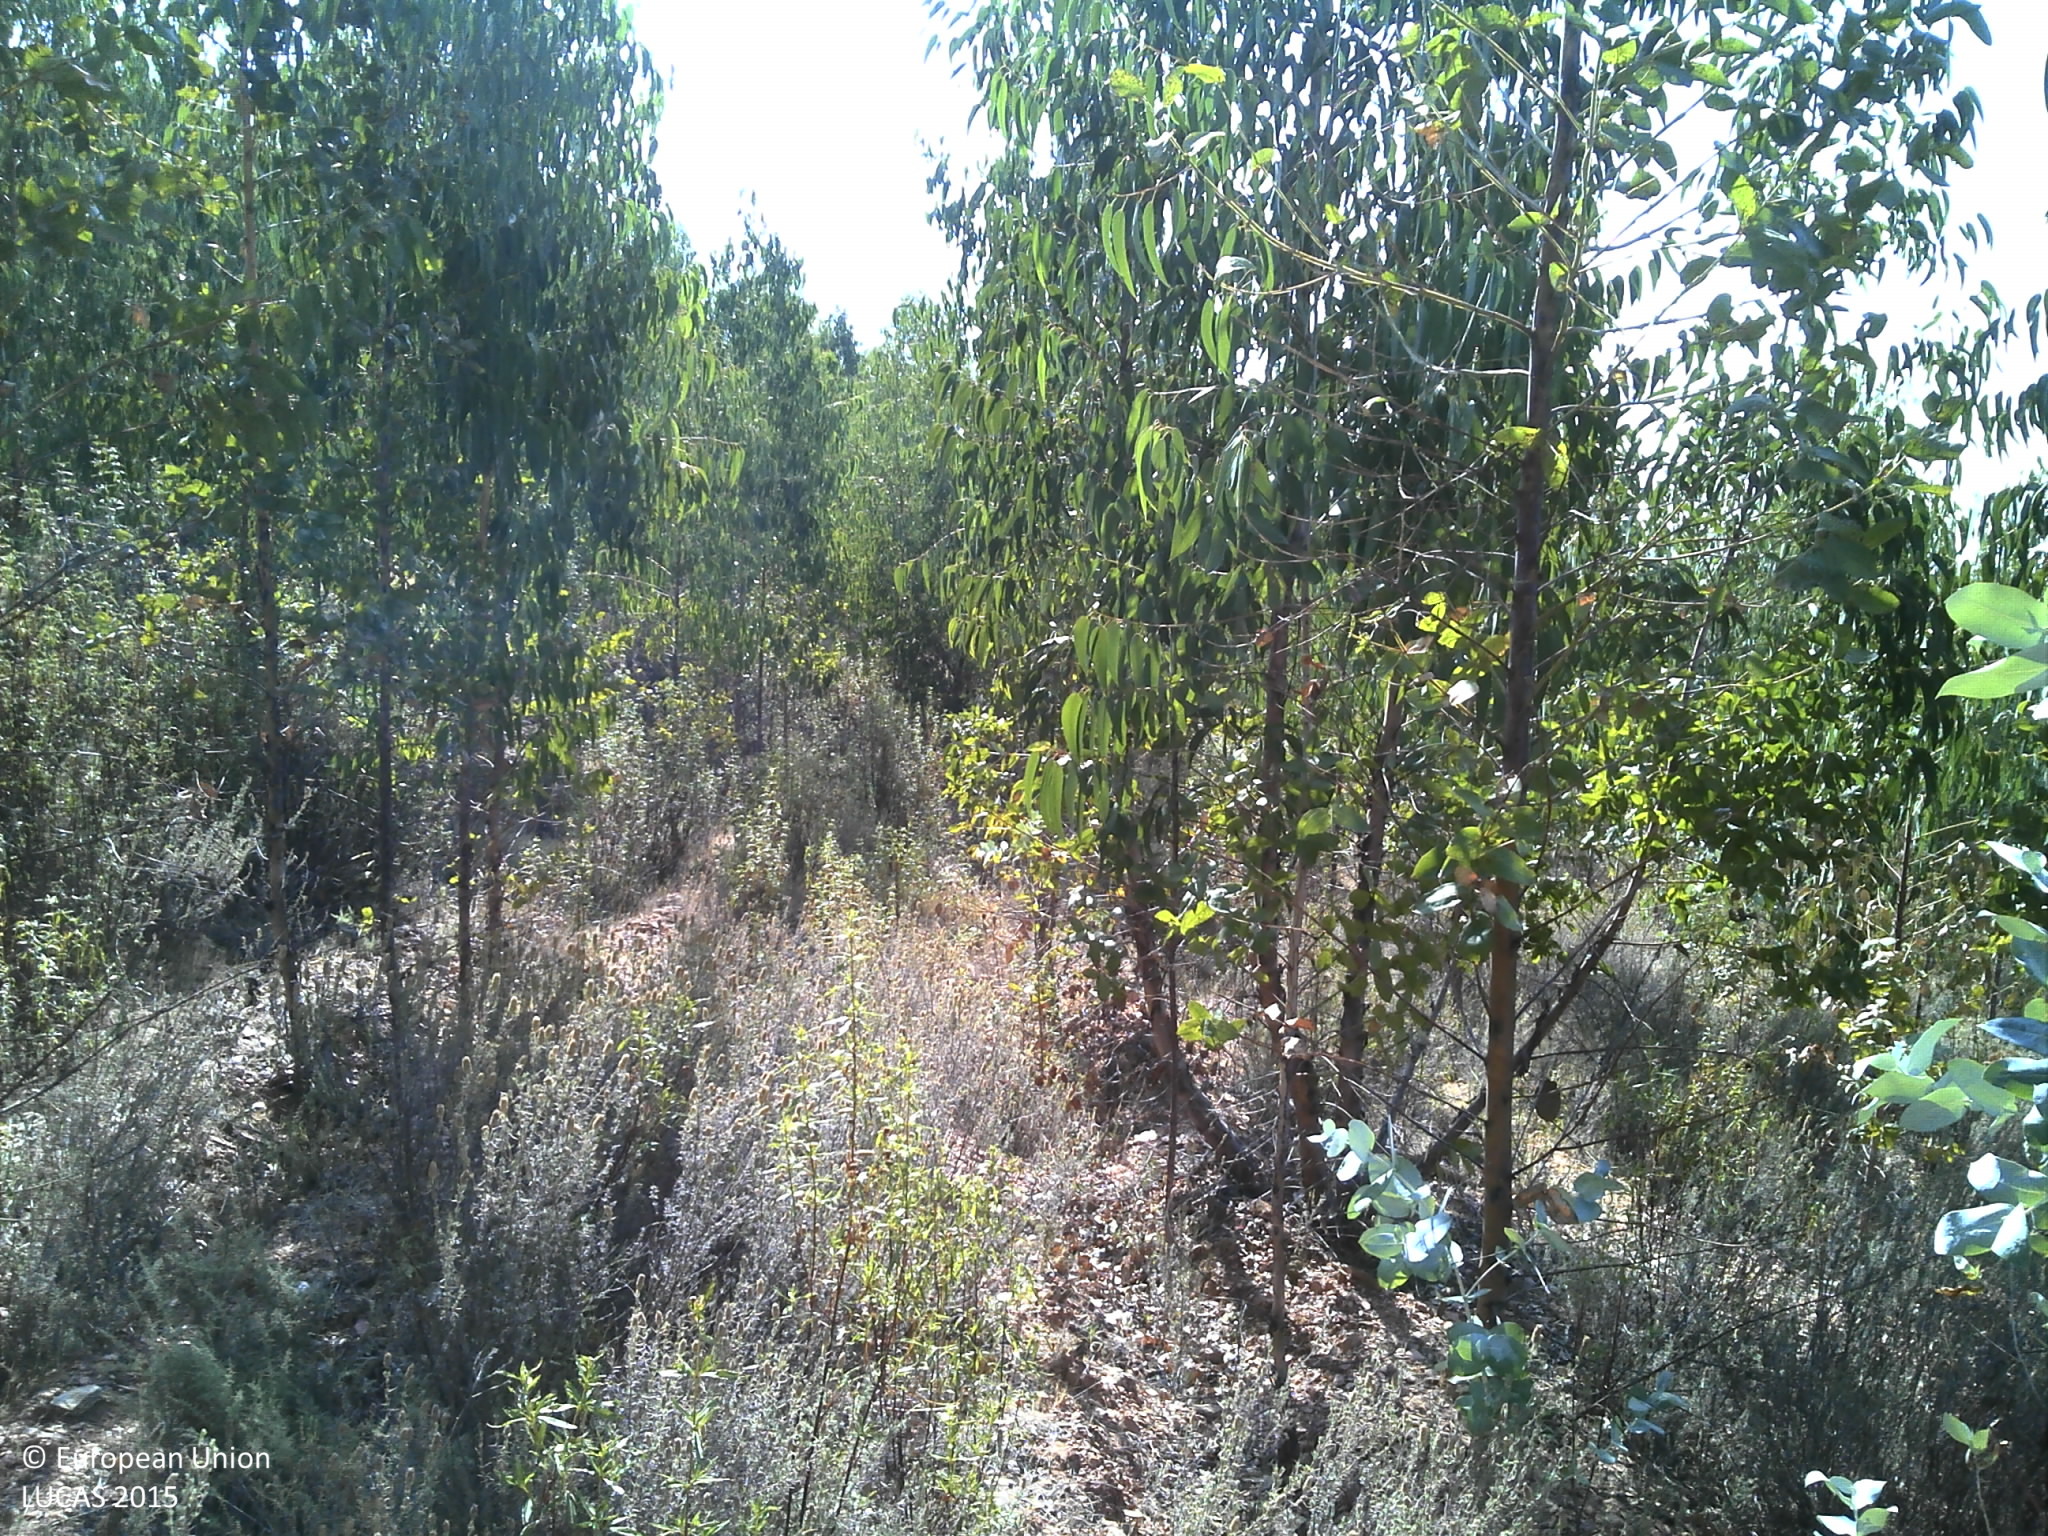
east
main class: Woodland
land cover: Broadleaved woodland
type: exotic forest
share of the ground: 25 - 50 %
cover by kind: broadleaved forest trees 40 %, shrubs 40 %, unconsolidated bare surface 20 %
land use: Forestry
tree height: > 5 m
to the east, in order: Broadleaved woodland; Tracks; Broadleaved woodland; Tracks; Grassland without tree/shrub cover
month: July
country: PT
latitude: 38.6114
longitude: -7.4744
